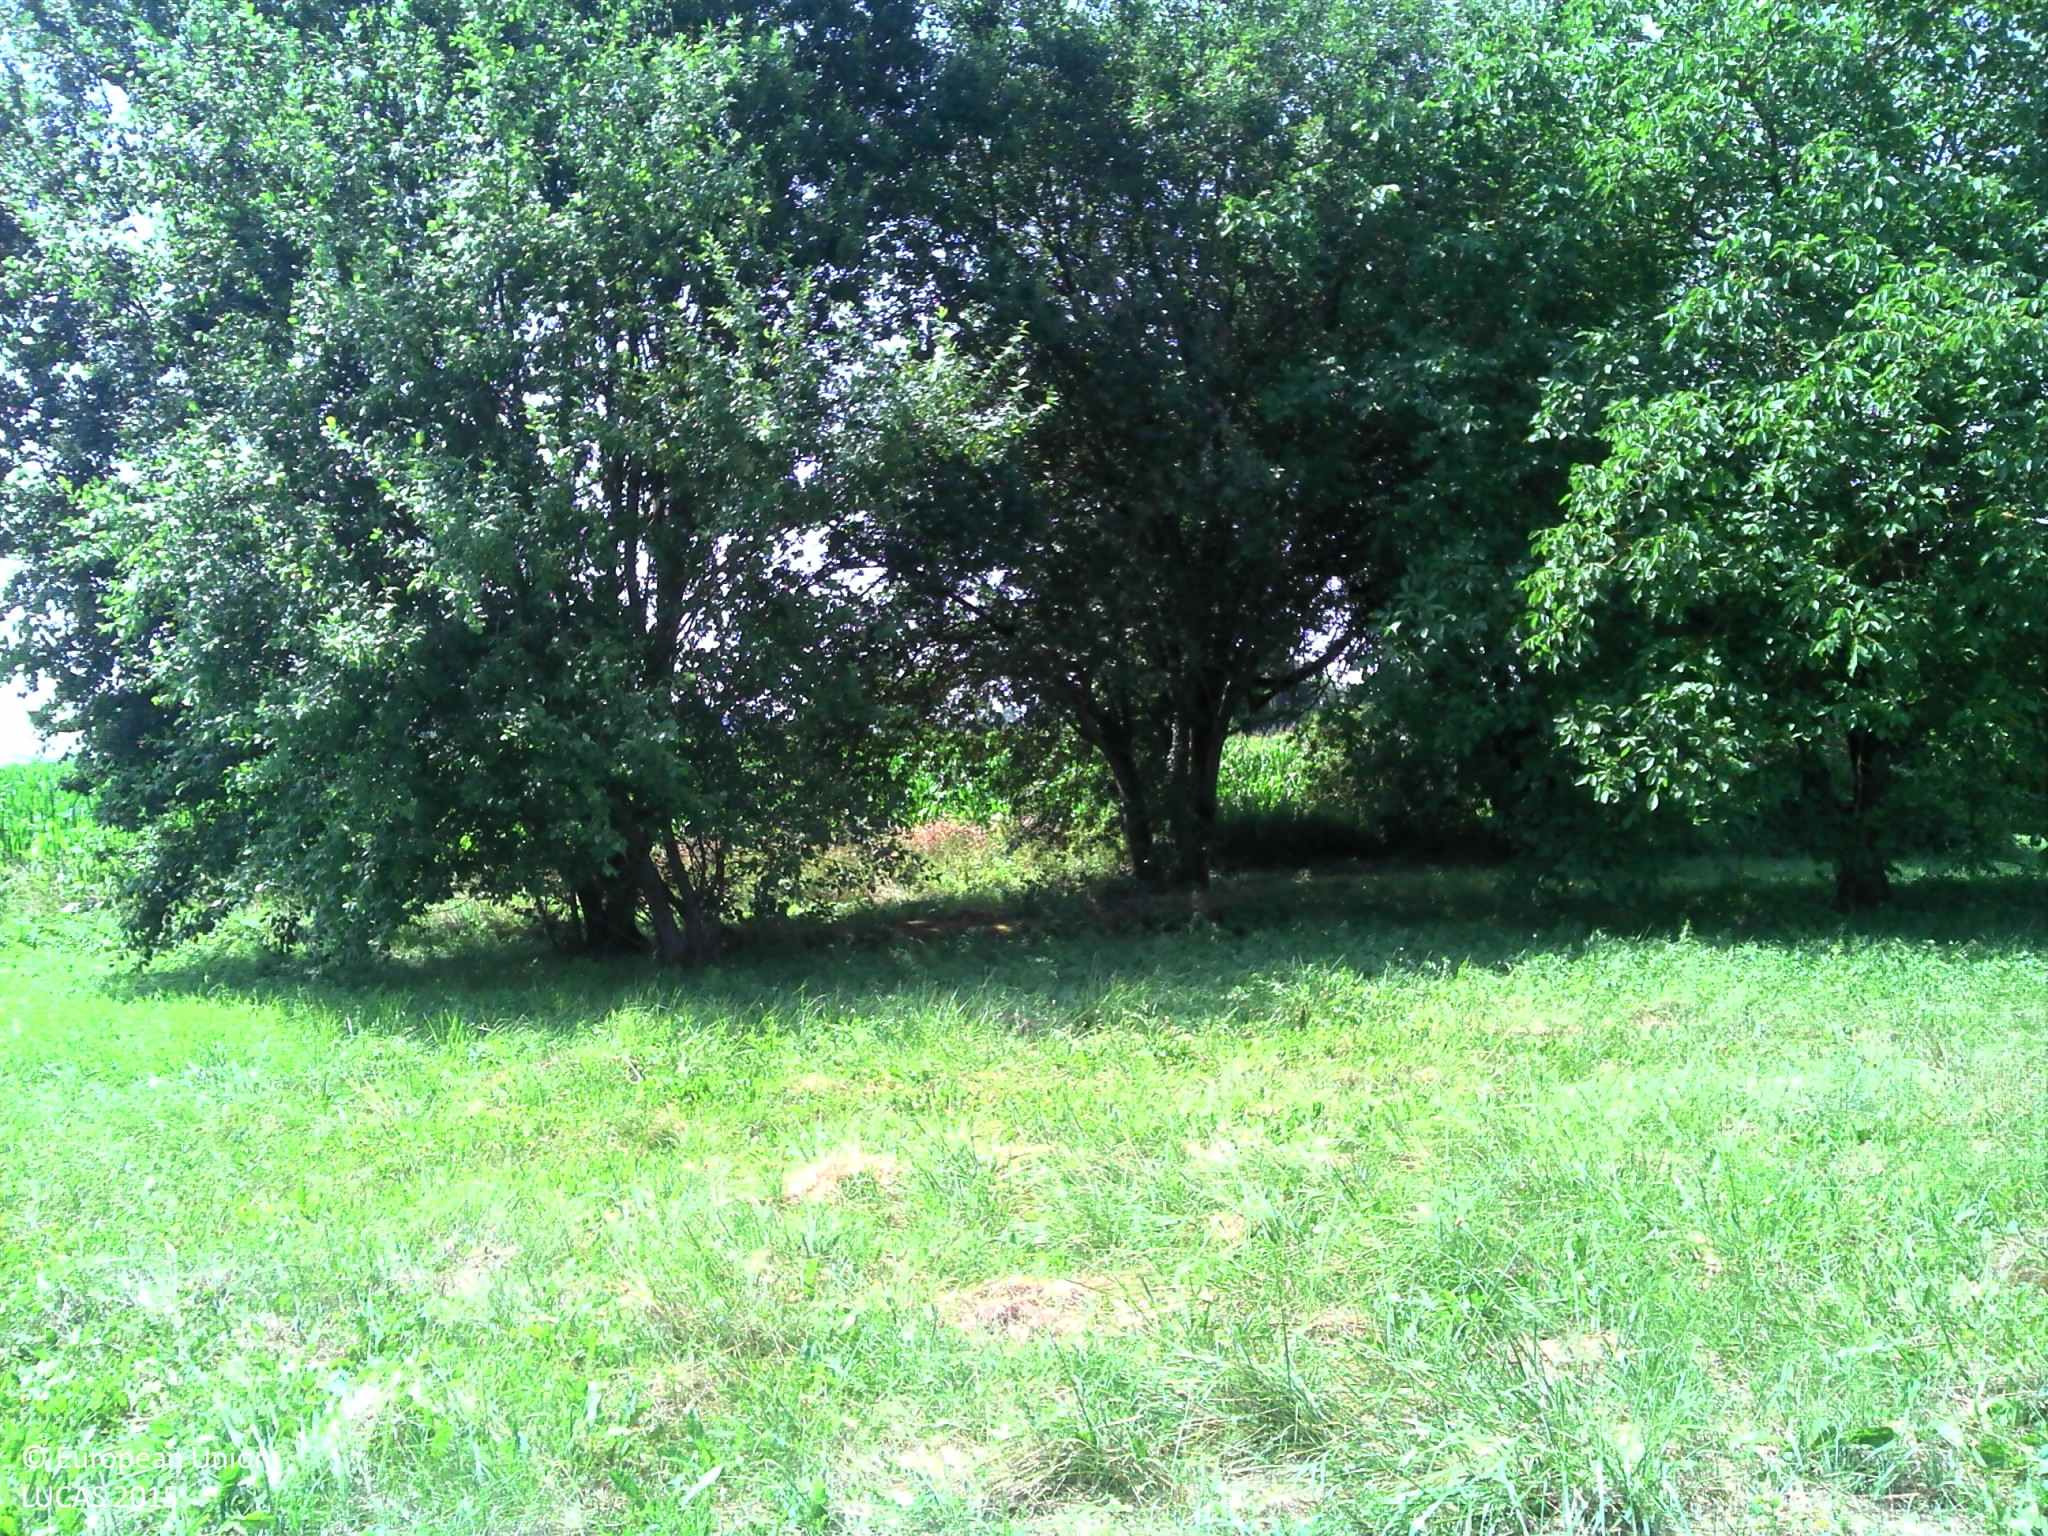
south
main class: Grassland
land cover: Grassland without tree/shrub cover
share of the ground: > 75 %
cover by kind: herbaceous plants 100 %
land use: Agriculture (excluding fallow land and kitchen gardens)
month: July
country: FR
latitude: 45.8197
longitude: 5.4091
